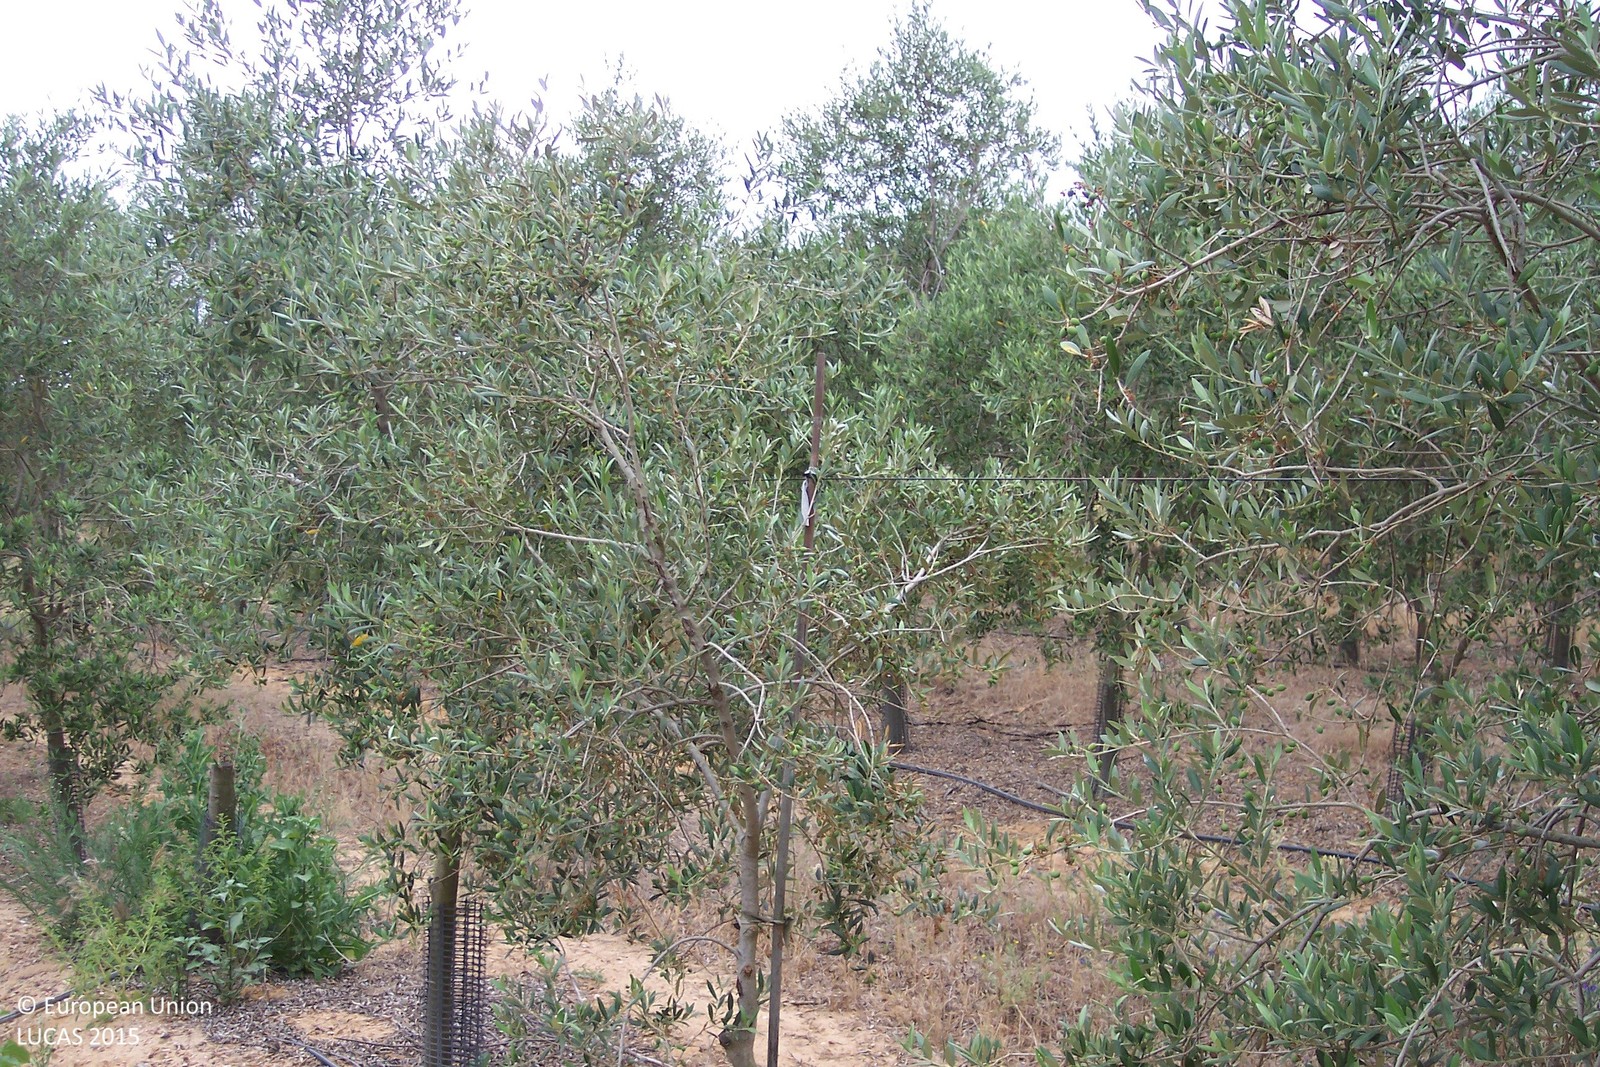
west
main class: Cropland
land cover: Olive groves
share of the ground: 25 - 50 %
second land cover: Spontaneously vegetated surfaces
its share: > 75 %
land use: Agriculture (excluding fallow land and kitchen gardens)
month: June
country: ES
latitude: 37.2810
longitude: -6.1413
